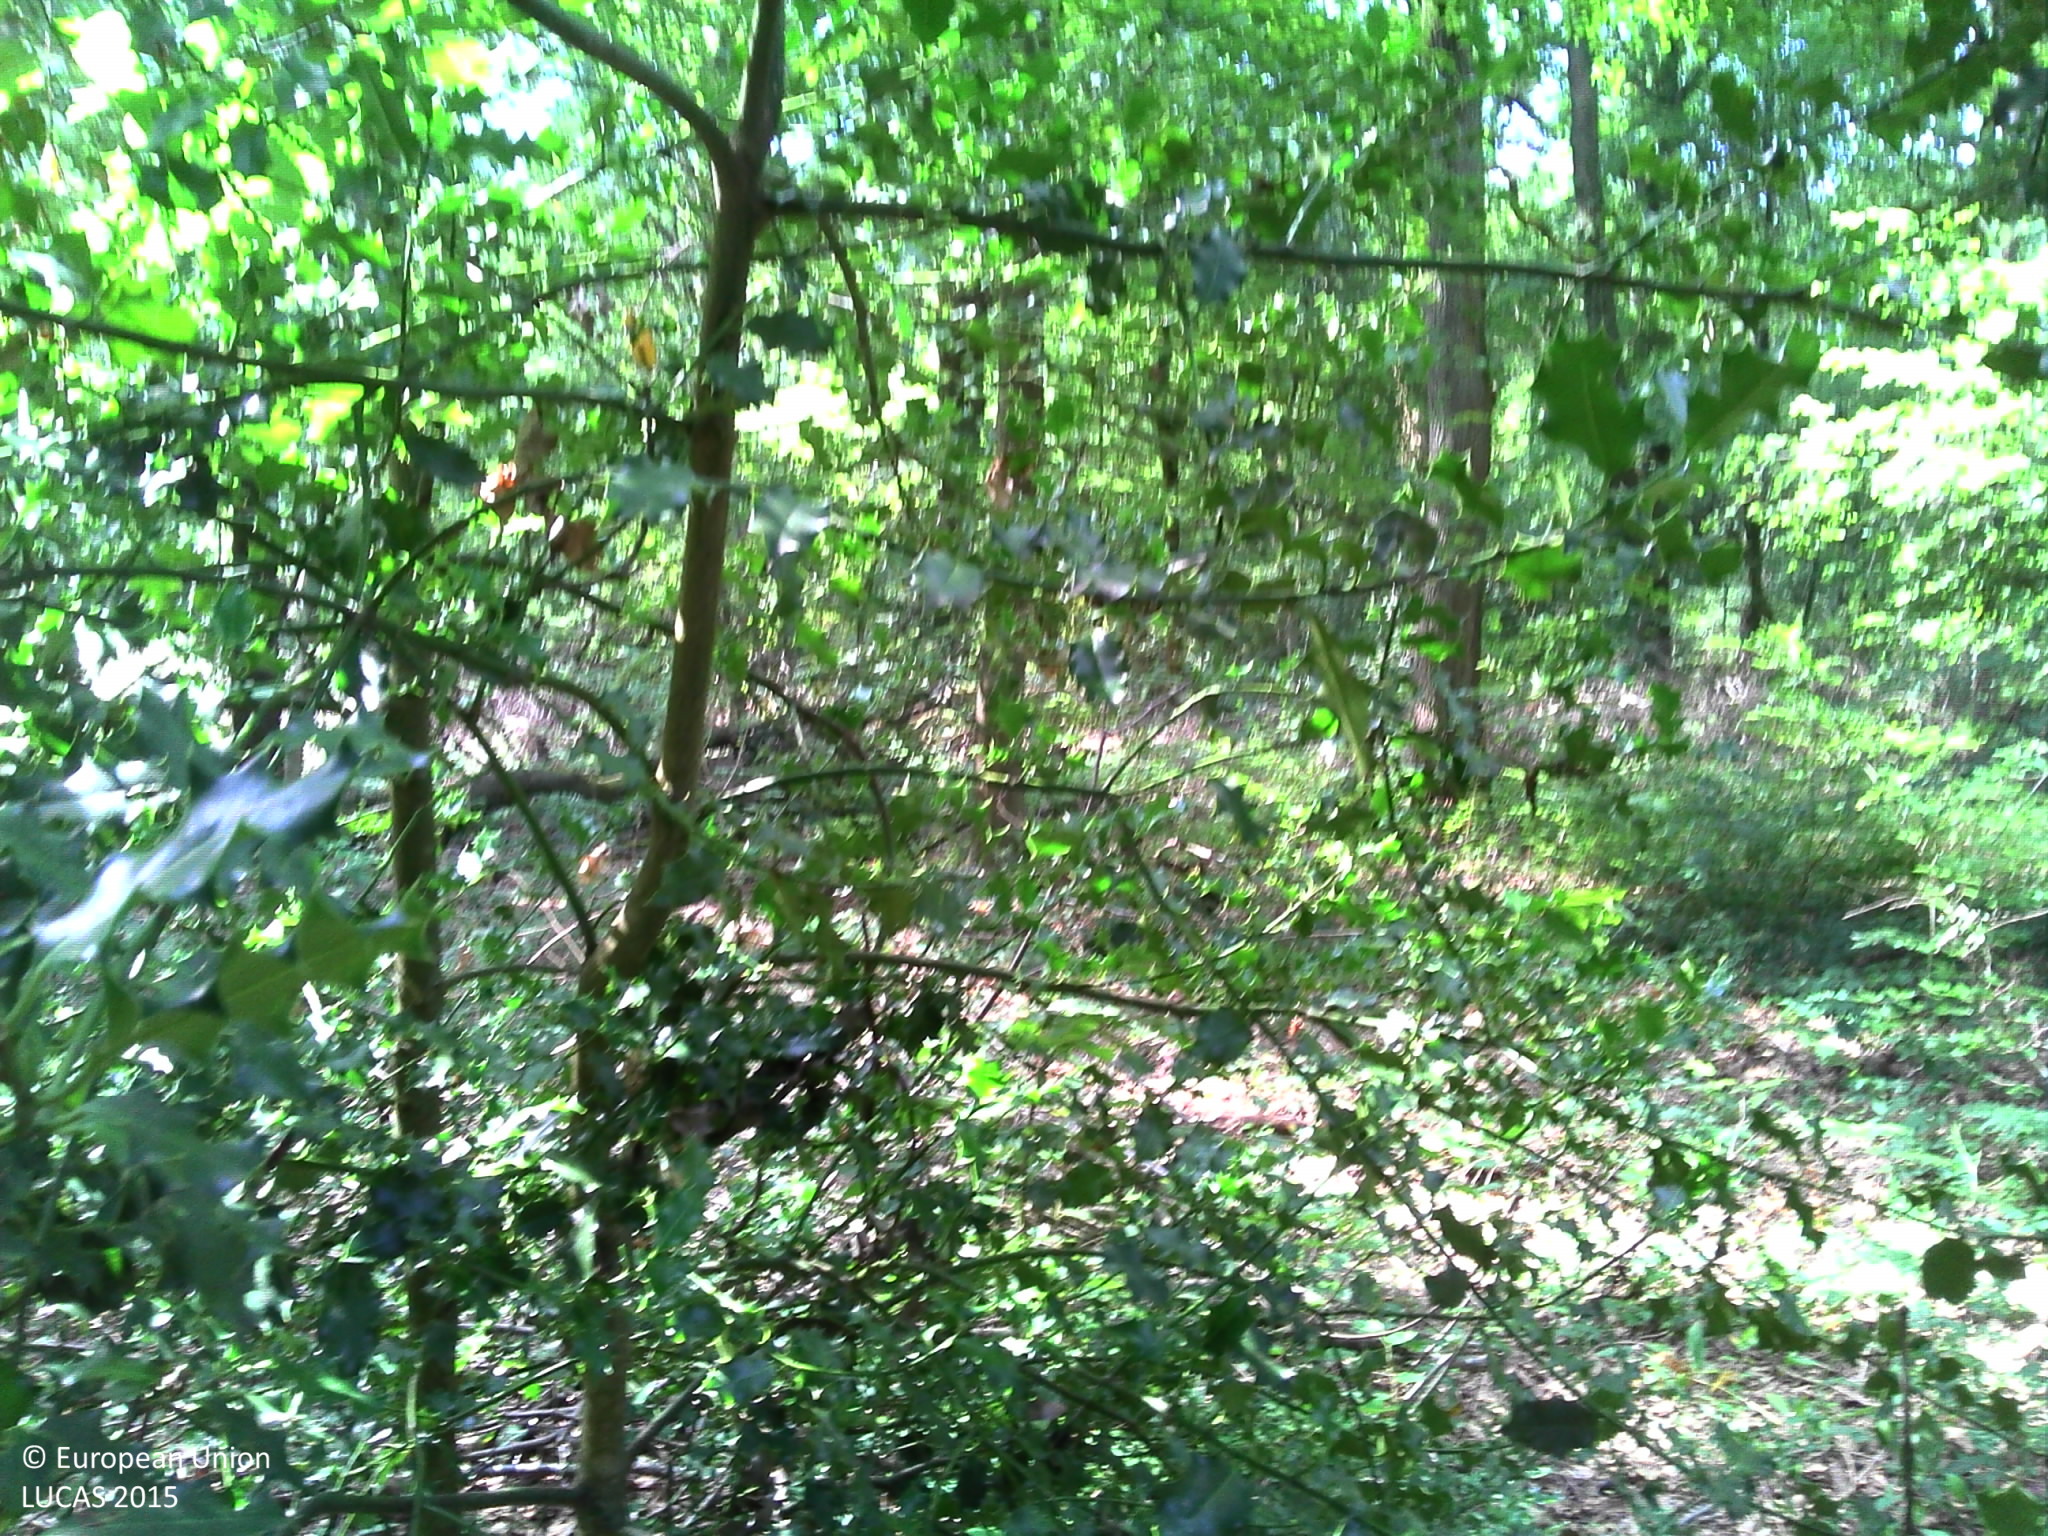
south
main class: Woodland
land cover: Broadleaved woodland
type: mesophytic deciduous forest
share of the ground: > 75 %
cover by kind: broadleaved forest trees 70 %, shrubs 20 %, herbaceous plants 10 %
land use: Forestry
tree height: > 5 m
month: August
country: BE
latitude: 50.3785
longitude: 4.5540
